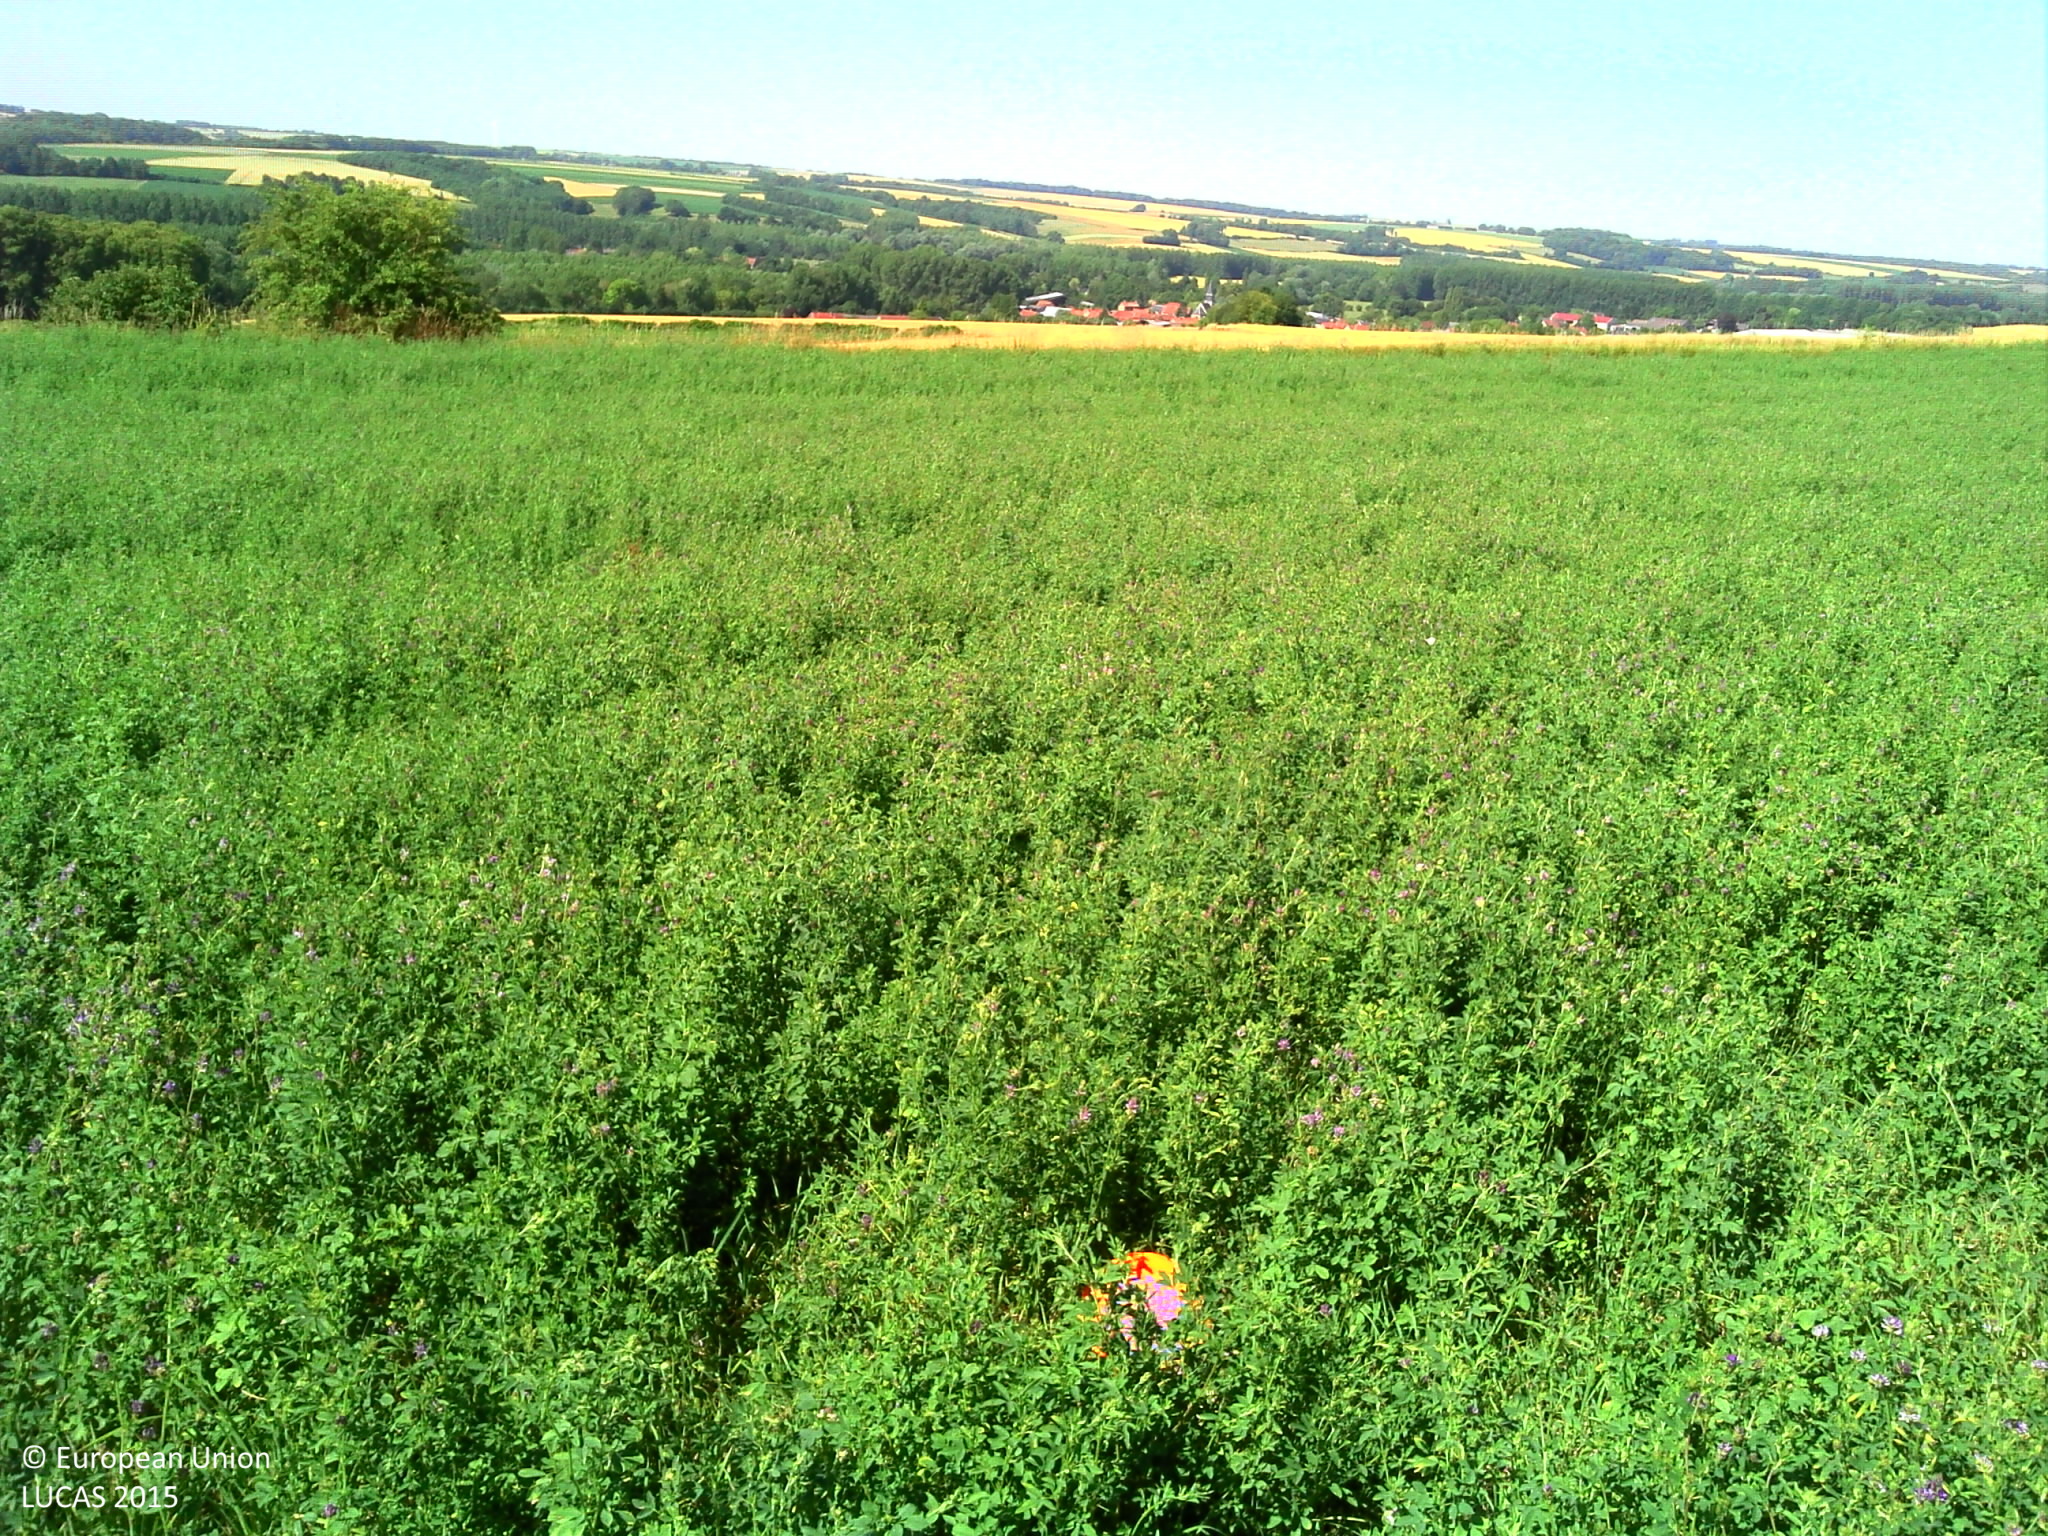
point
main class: Cropland
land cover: Lucerne
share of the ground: > 75 %
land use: Agriculture (excluding fallow land and kitchen gardens)
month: July
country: FR
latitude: 50.2225
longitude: 2.1786
